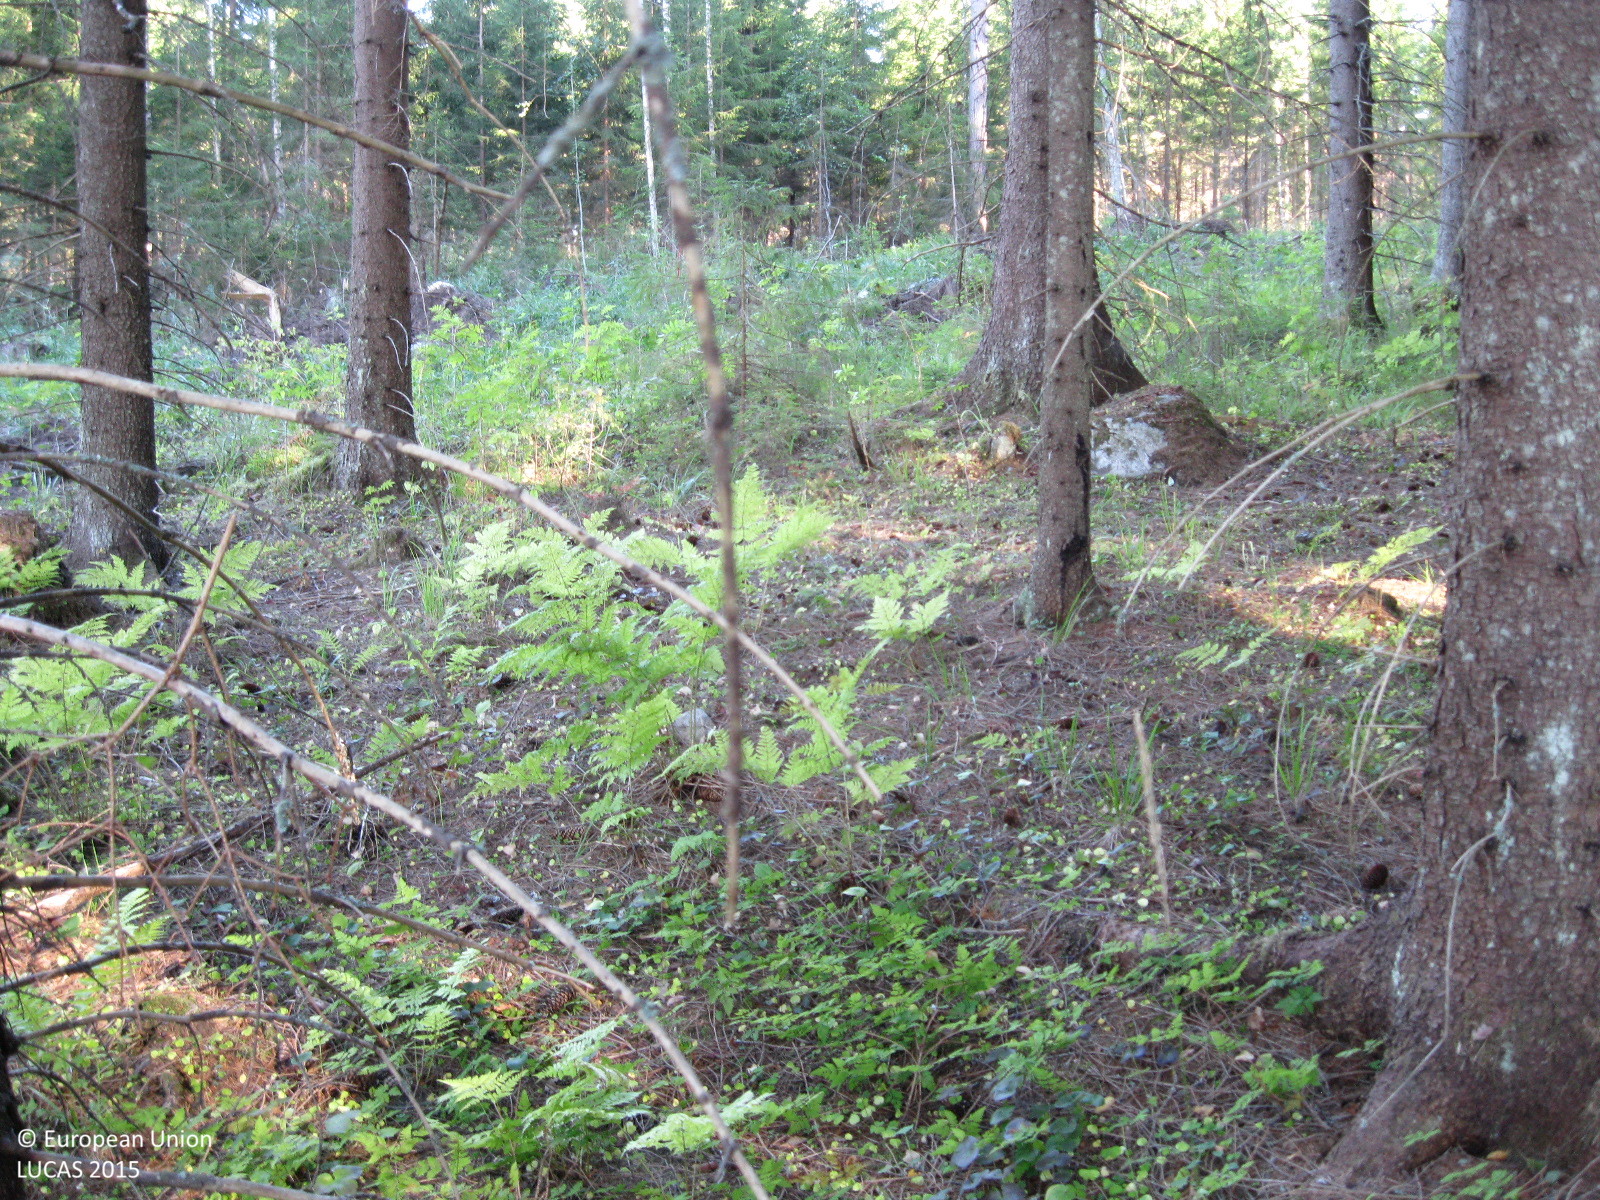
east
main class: Woodland
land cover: Spruce dominated coniferous woodland
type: boreal forest
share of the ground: > 75 %
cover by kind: coniferous forest trees 90 %, herbaceous plants 10 %
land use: Forestry
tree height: > 5 m
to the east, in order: Spruce dominated coniferous woodland; Grassland without tree/shrub cover; Spruce dominated coniferous woodland; Grassland without tree/shrub cover; Spruce dominated mixed woodland; Tracks; Spruce dominated coniferous woodland
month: August
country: FI
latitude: 61.4128
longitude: 25.3493
